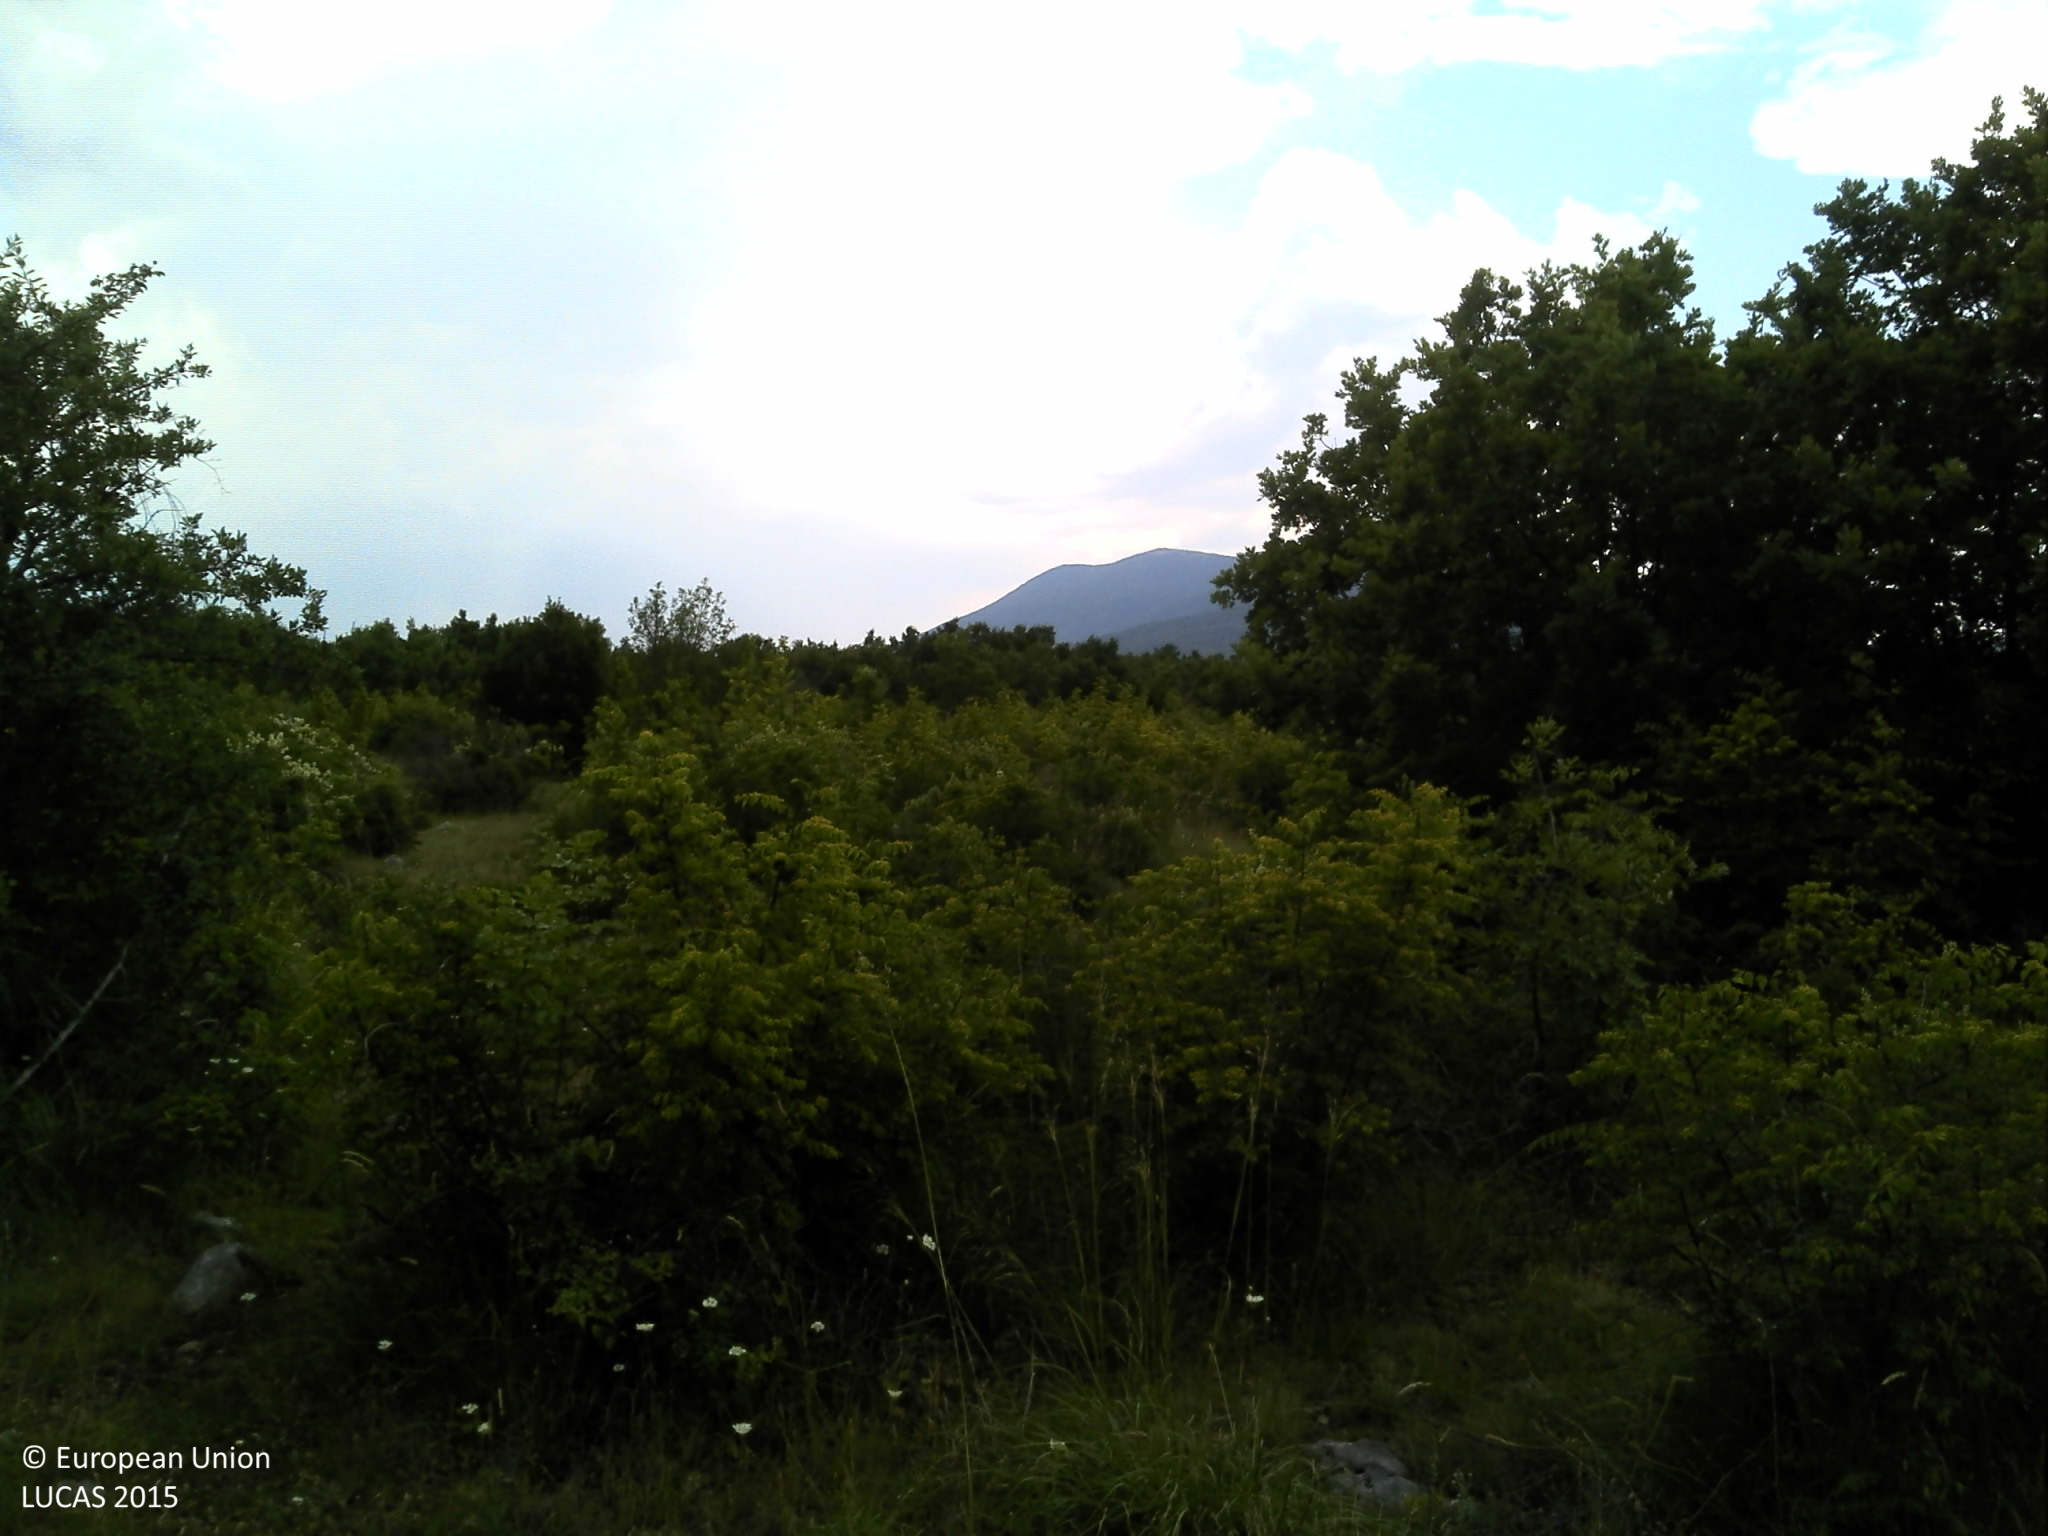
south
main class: Shrubland
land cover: Shrubland with sparse tree cover
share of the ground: 50 - 75 %
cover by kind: shrubs 45 %, herbaceous plants 45 %, broadleaved forest trees 5 %, unconsolidated bare surface 5 %
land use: Semi-natural and natural areas not in use
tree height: < 5 m
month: June
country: HR
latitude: 44.0059
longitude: 16.1411
